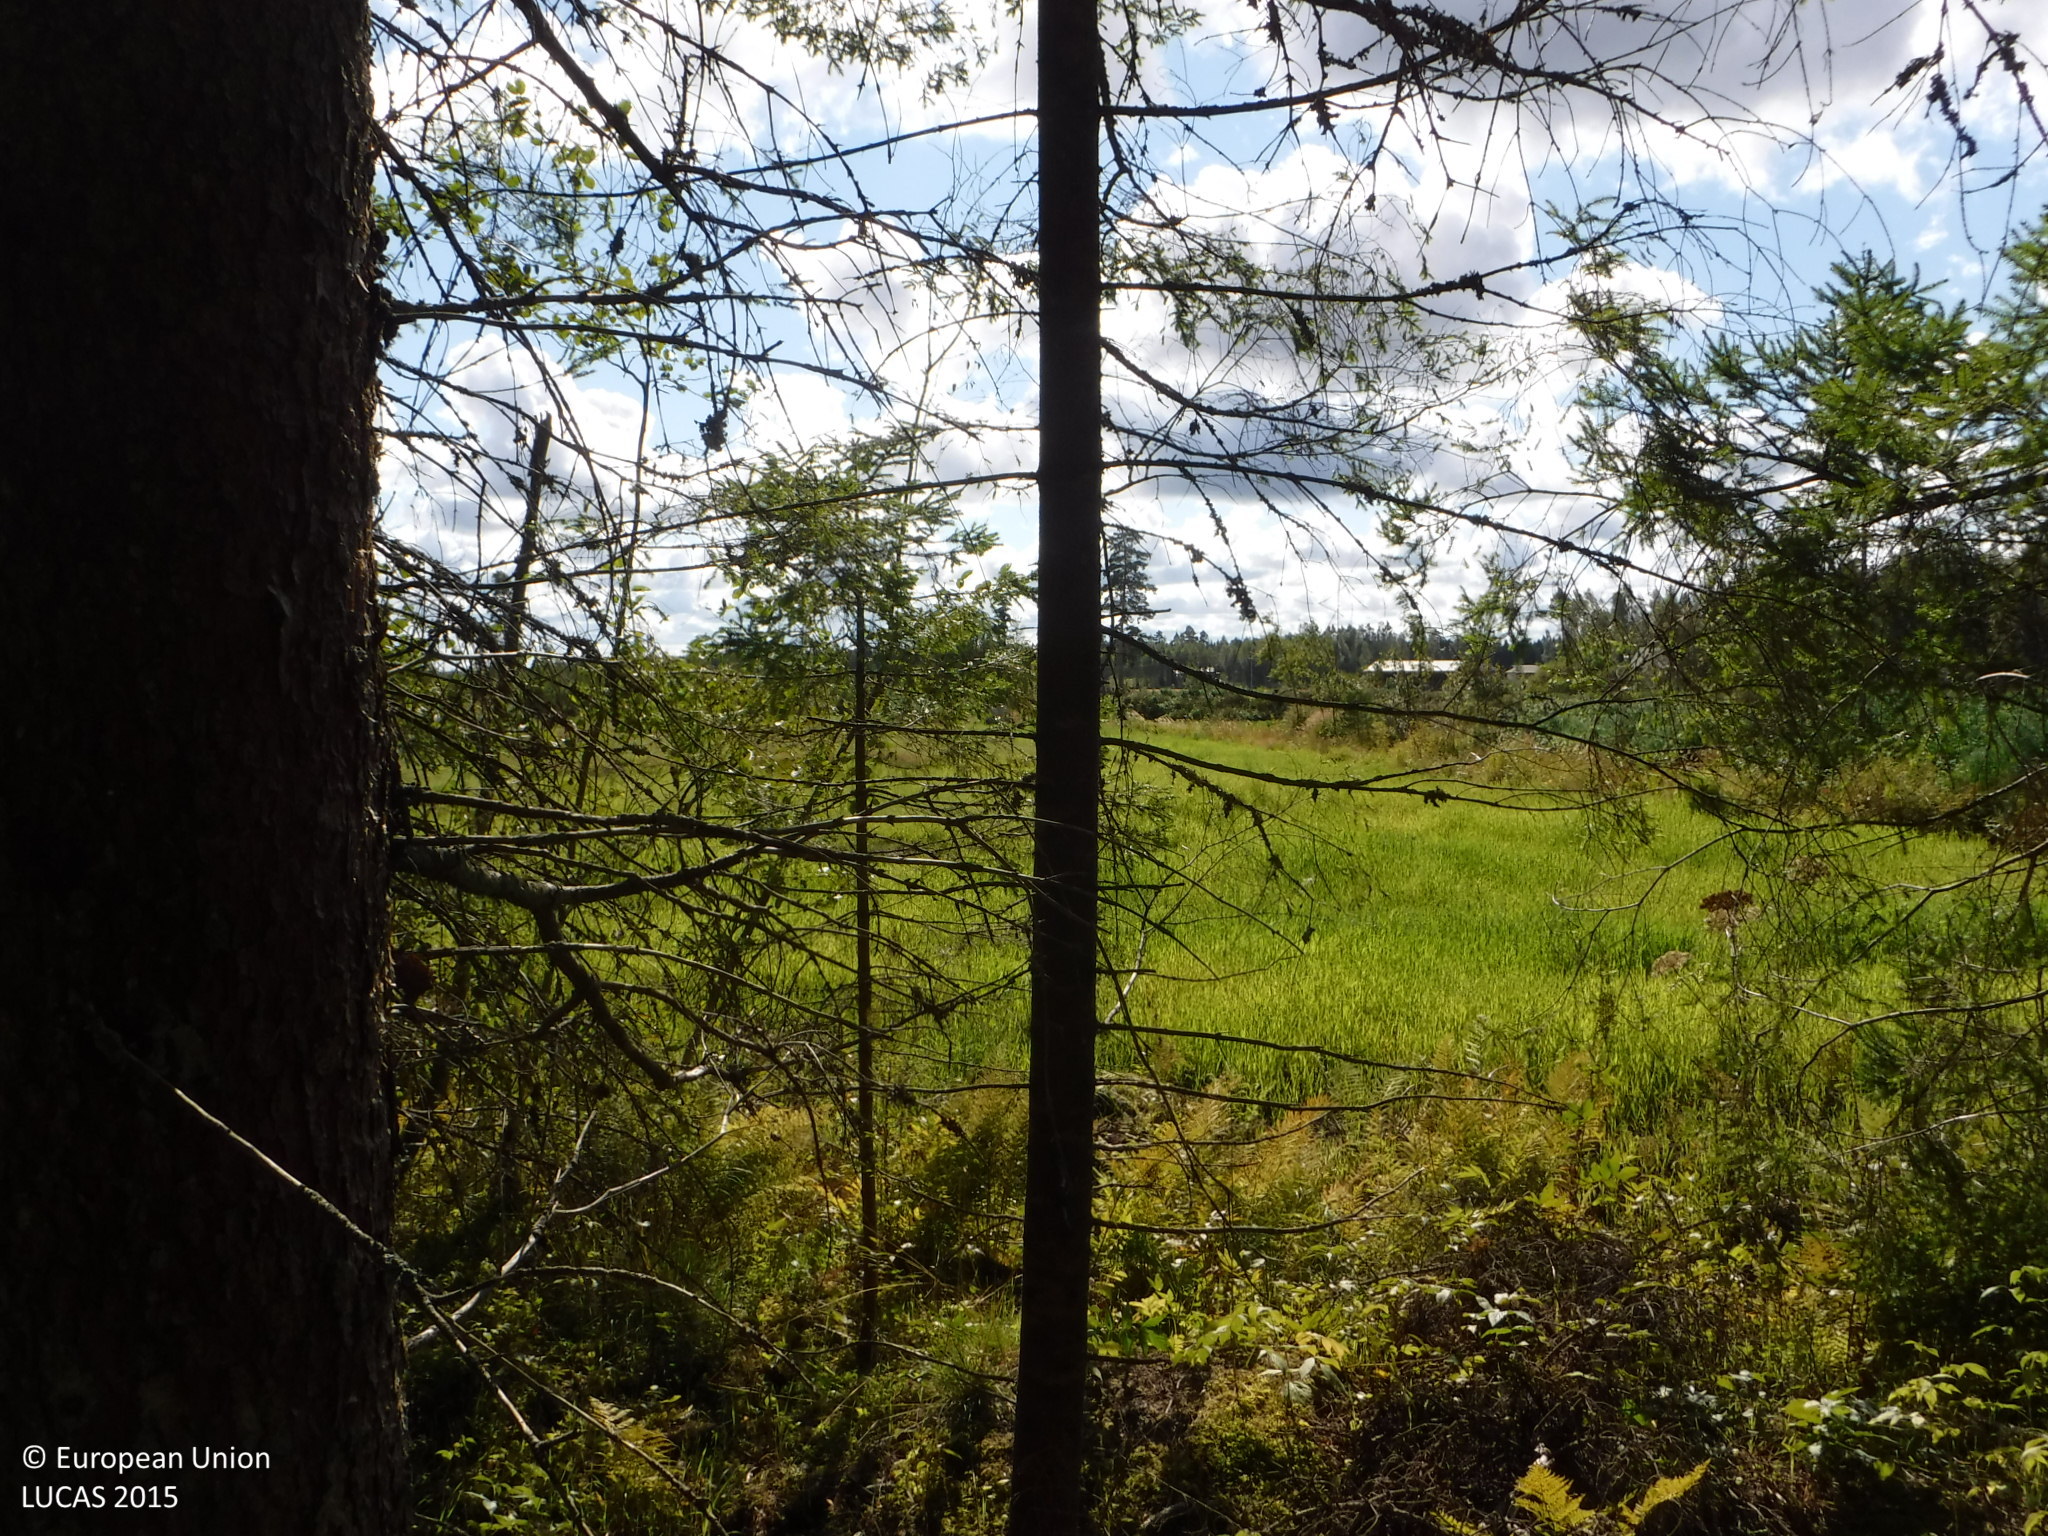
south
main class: Woodland
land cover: Spruce dominated coniferous woodland
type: boreal forest
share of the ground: > 75 %
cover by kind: coniferous forest trees 75 %, lichens and mosses 20 %, shrubs 5 %
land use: Forestry
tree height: > 5 m
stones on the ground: < 10 %
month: August
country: FI
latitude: 61.2624
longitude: 21.8963
